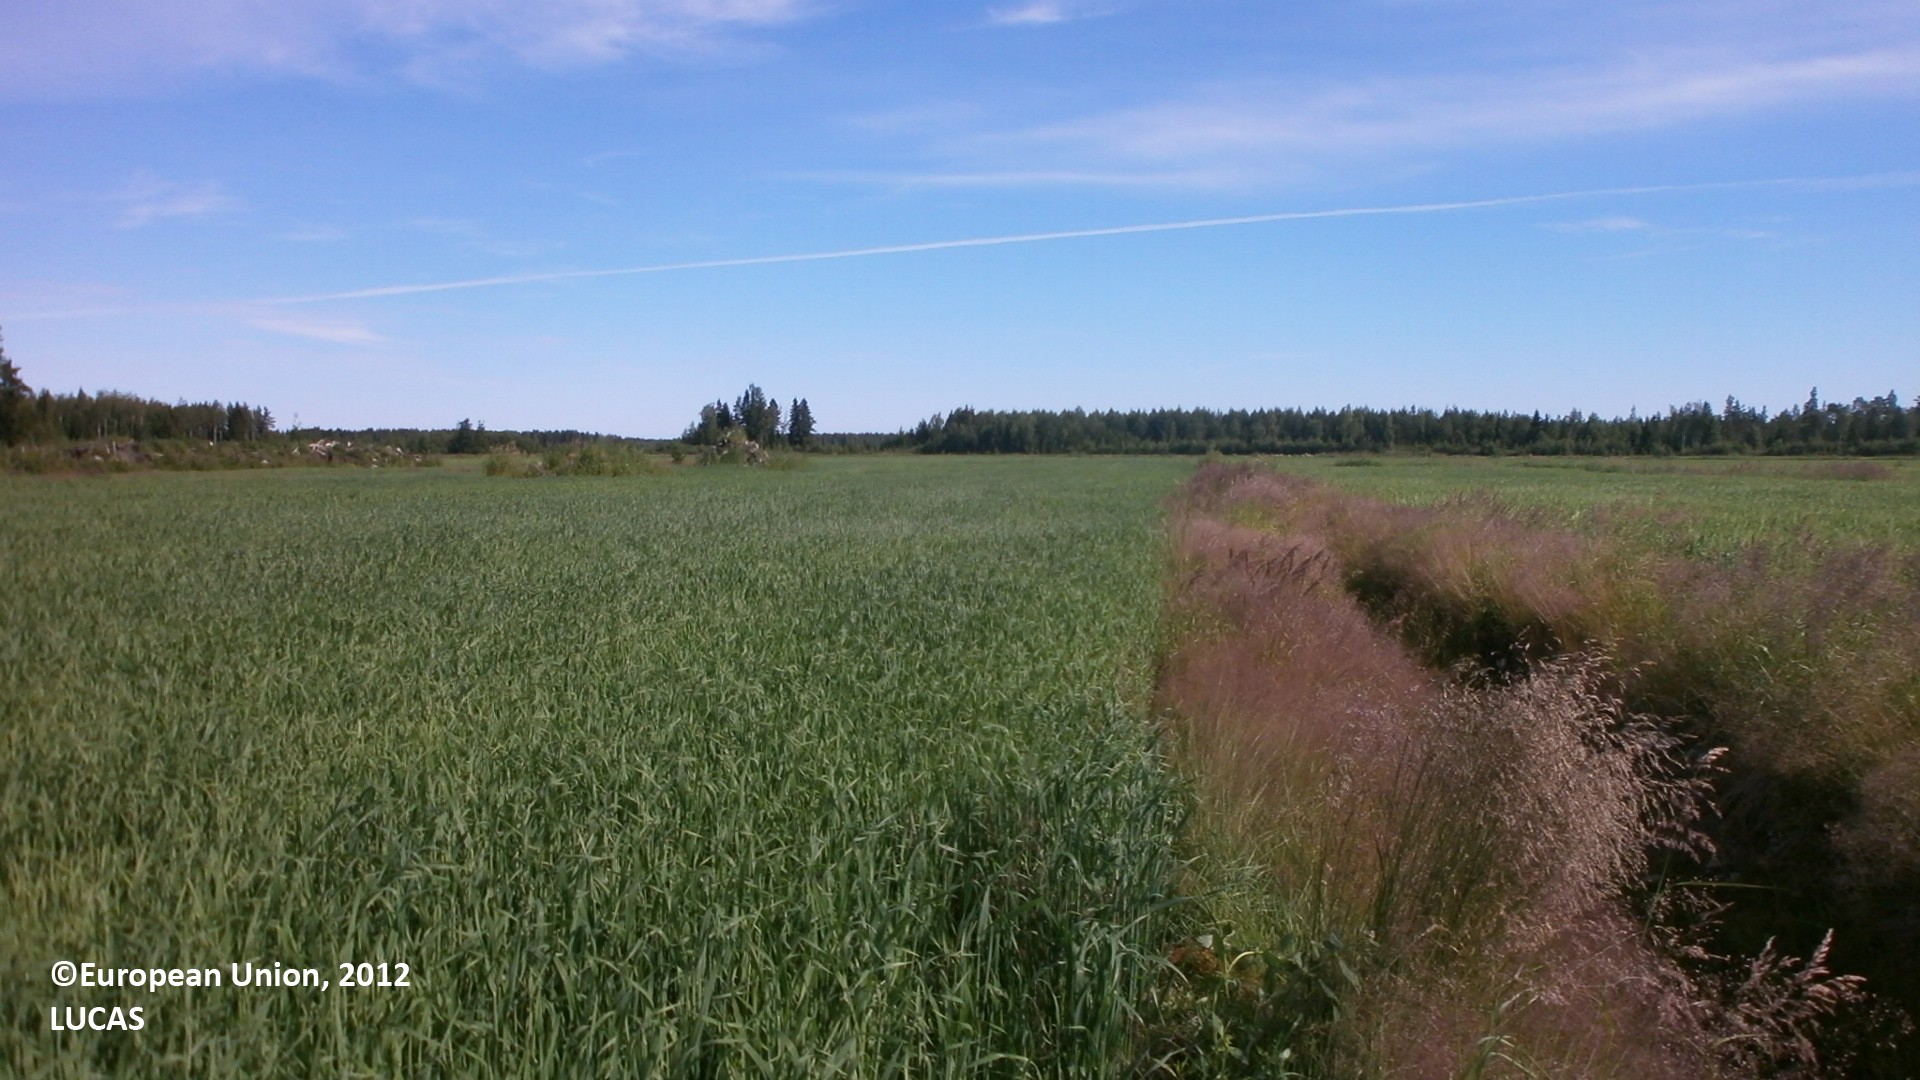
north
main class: Cropland
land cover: Oats
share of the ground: > 75 %
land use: Agriculture (excluding fallow land and kitchen gardens)
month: July
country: FI
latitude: 64.4007
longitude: 24.1907
